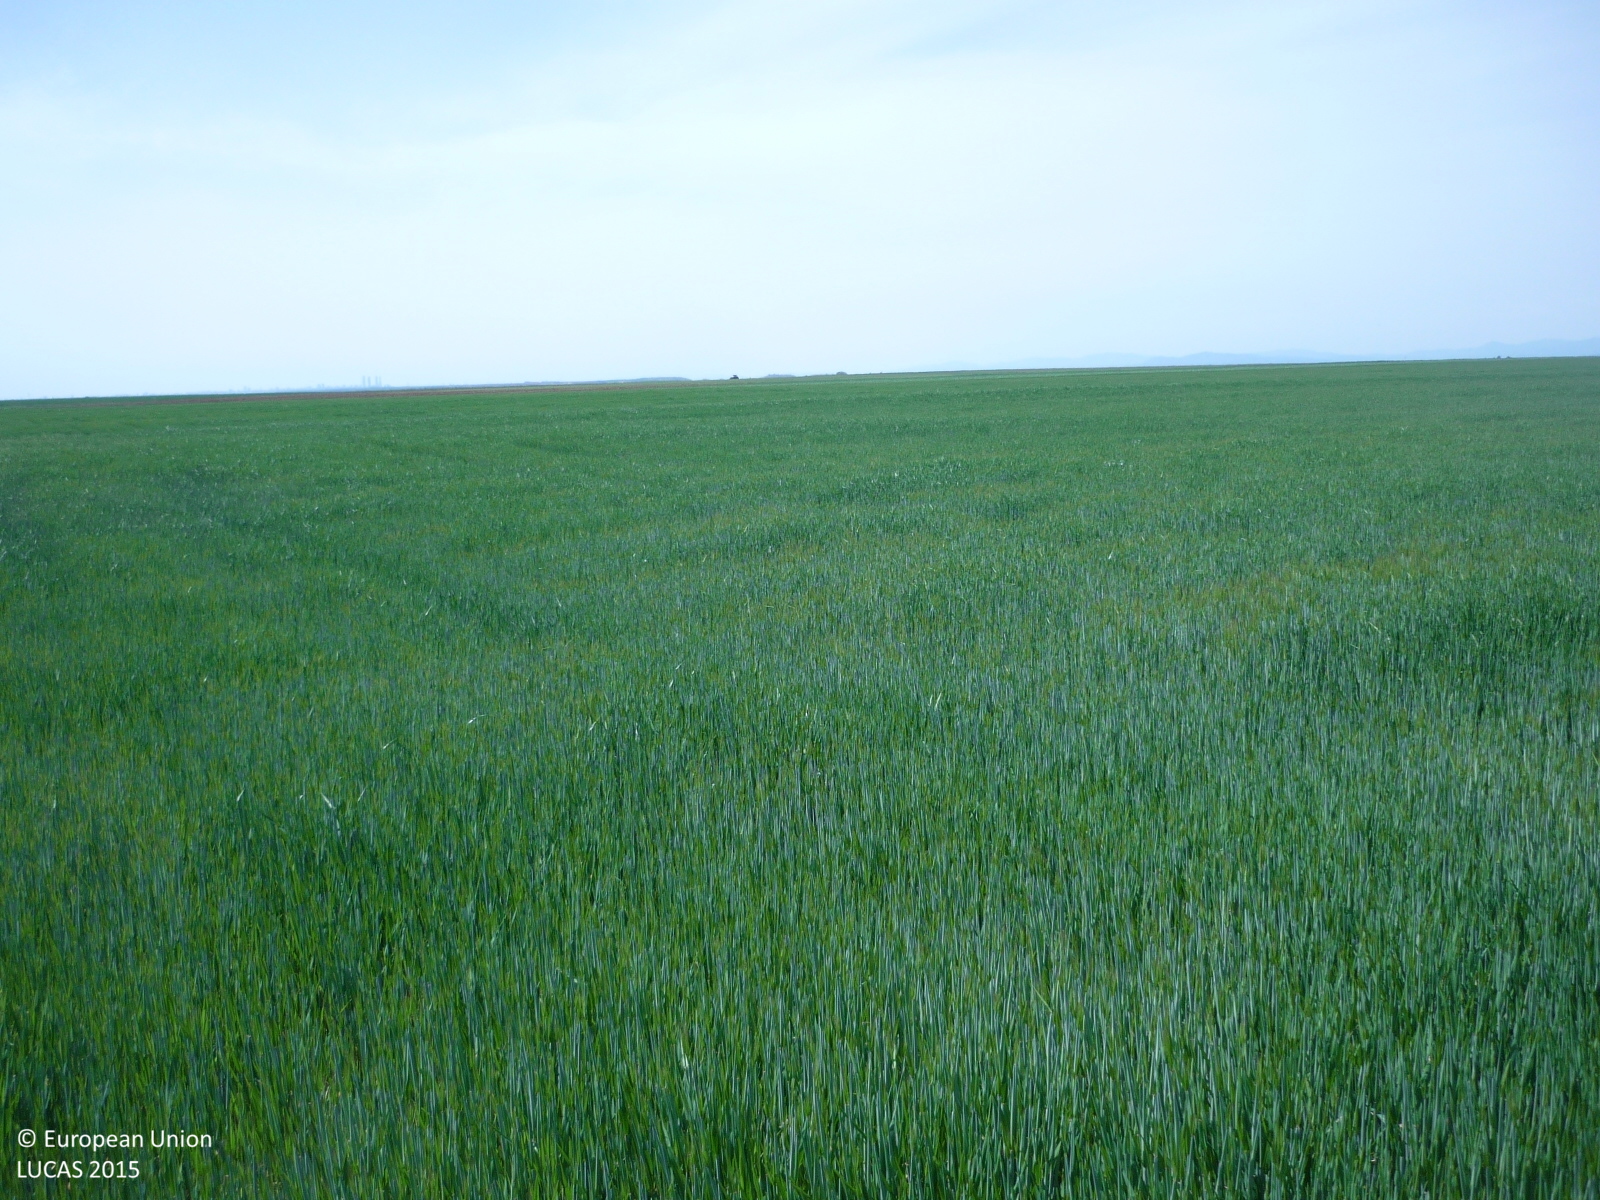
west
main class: Cropland
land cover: Common wheat
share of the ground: > 75 %
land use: Agriculture (excluding fallow land and kitchen gardens)
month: April
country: ES
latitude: 40.5982
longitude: -3.3291
